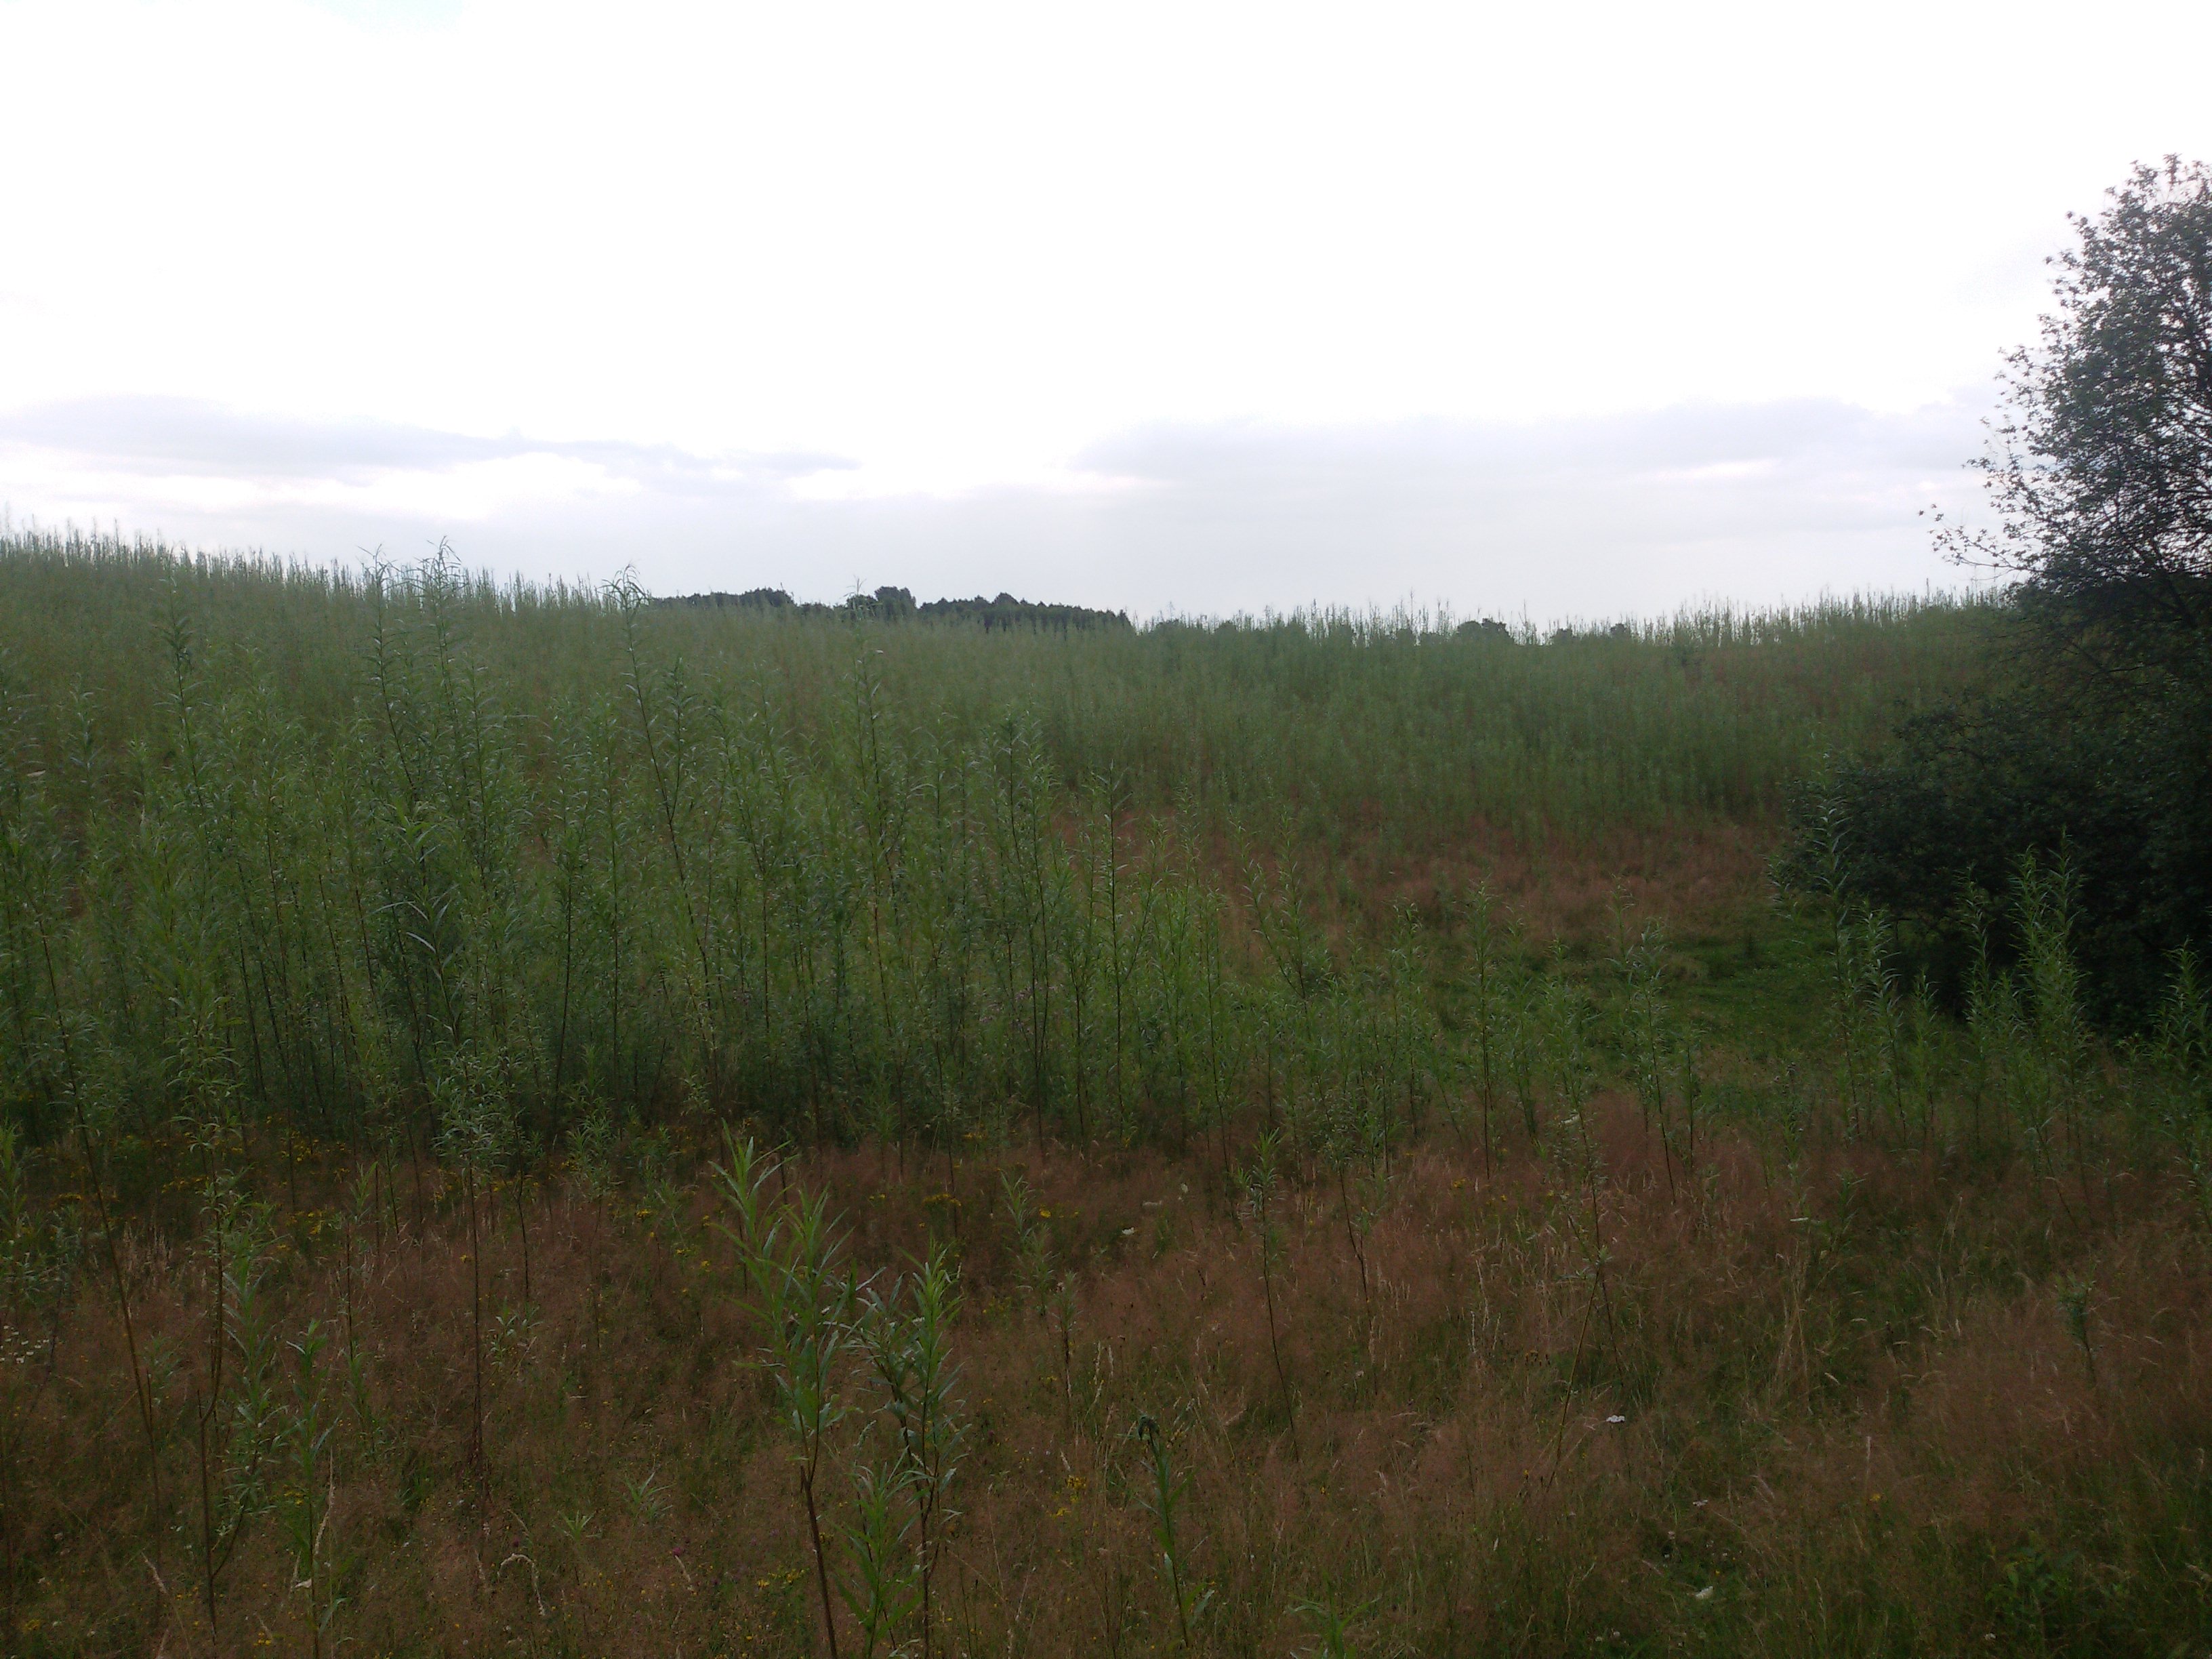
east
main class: Woodland
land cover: Broadleaved woodland
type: mesophytic deciduous forest
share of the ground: 50 - 75 %
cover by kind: broadleaved forest trees 60 %, shrubs 30 %, herbaceous plants 10 %
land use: Semi-natural and natural areas not in use
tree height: > 5 m
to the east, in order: Broadleaved woodland; Spontaneously vegetated surfaces
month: July
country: PL
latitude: 53.5535
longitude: 15.7550
